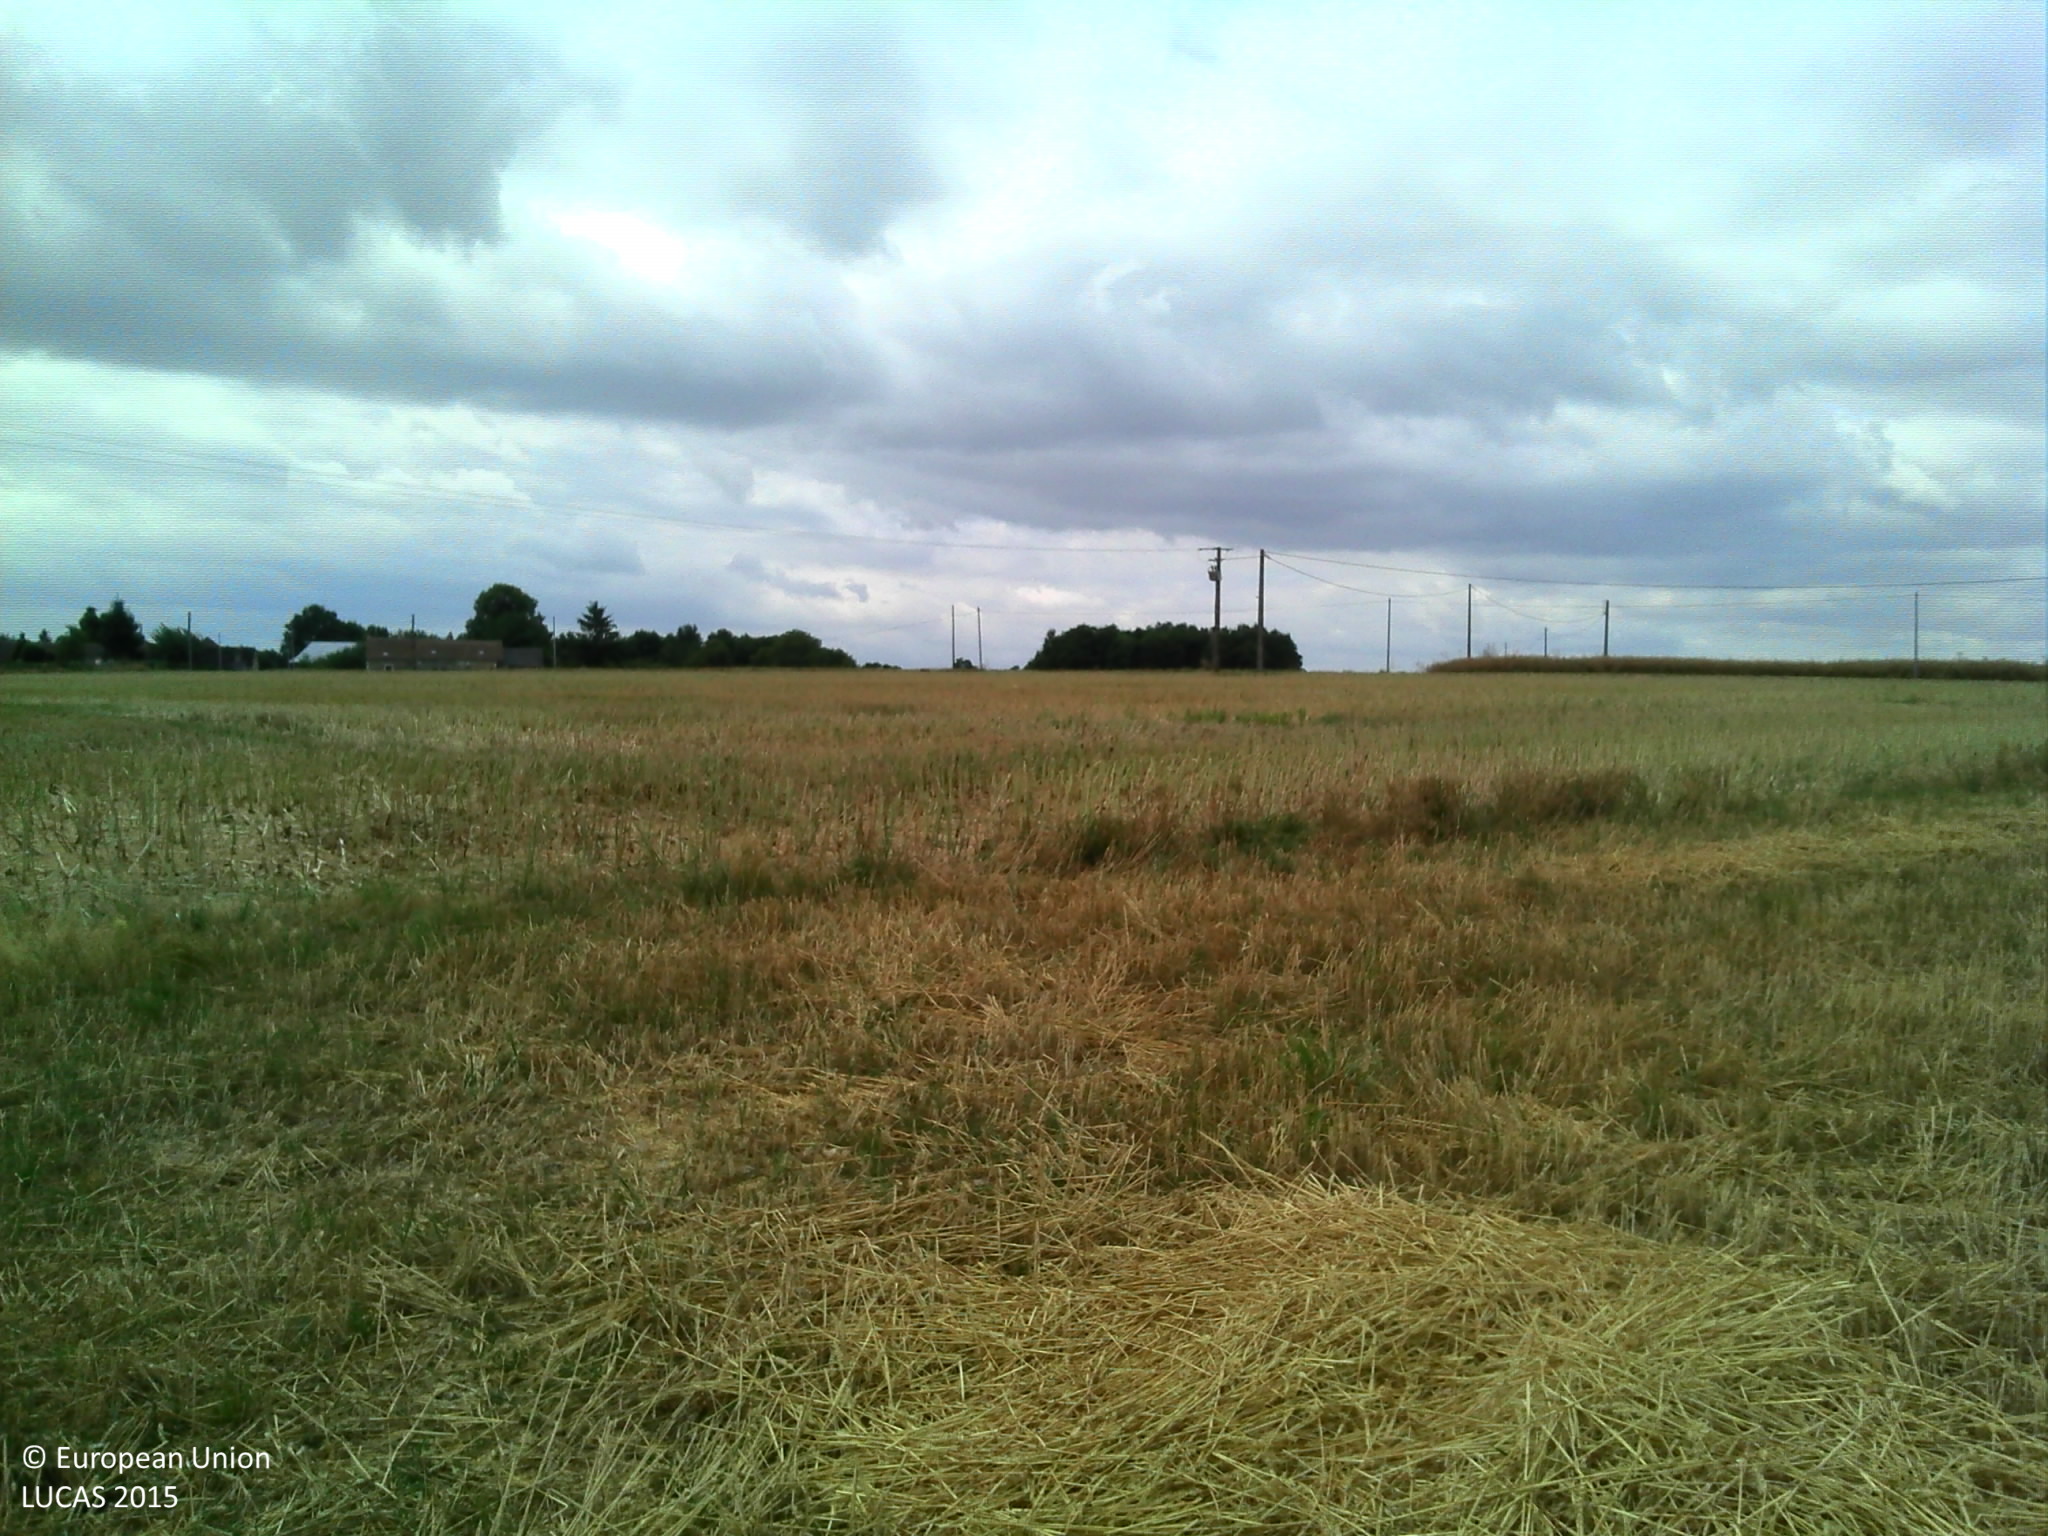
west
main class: Cropland
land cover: Common wheat
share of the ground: > 75 %
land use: Agriculture (excluding fallow land and kitchen gardens)
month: July
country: FR
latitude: 47.6412
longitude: 0.4067
